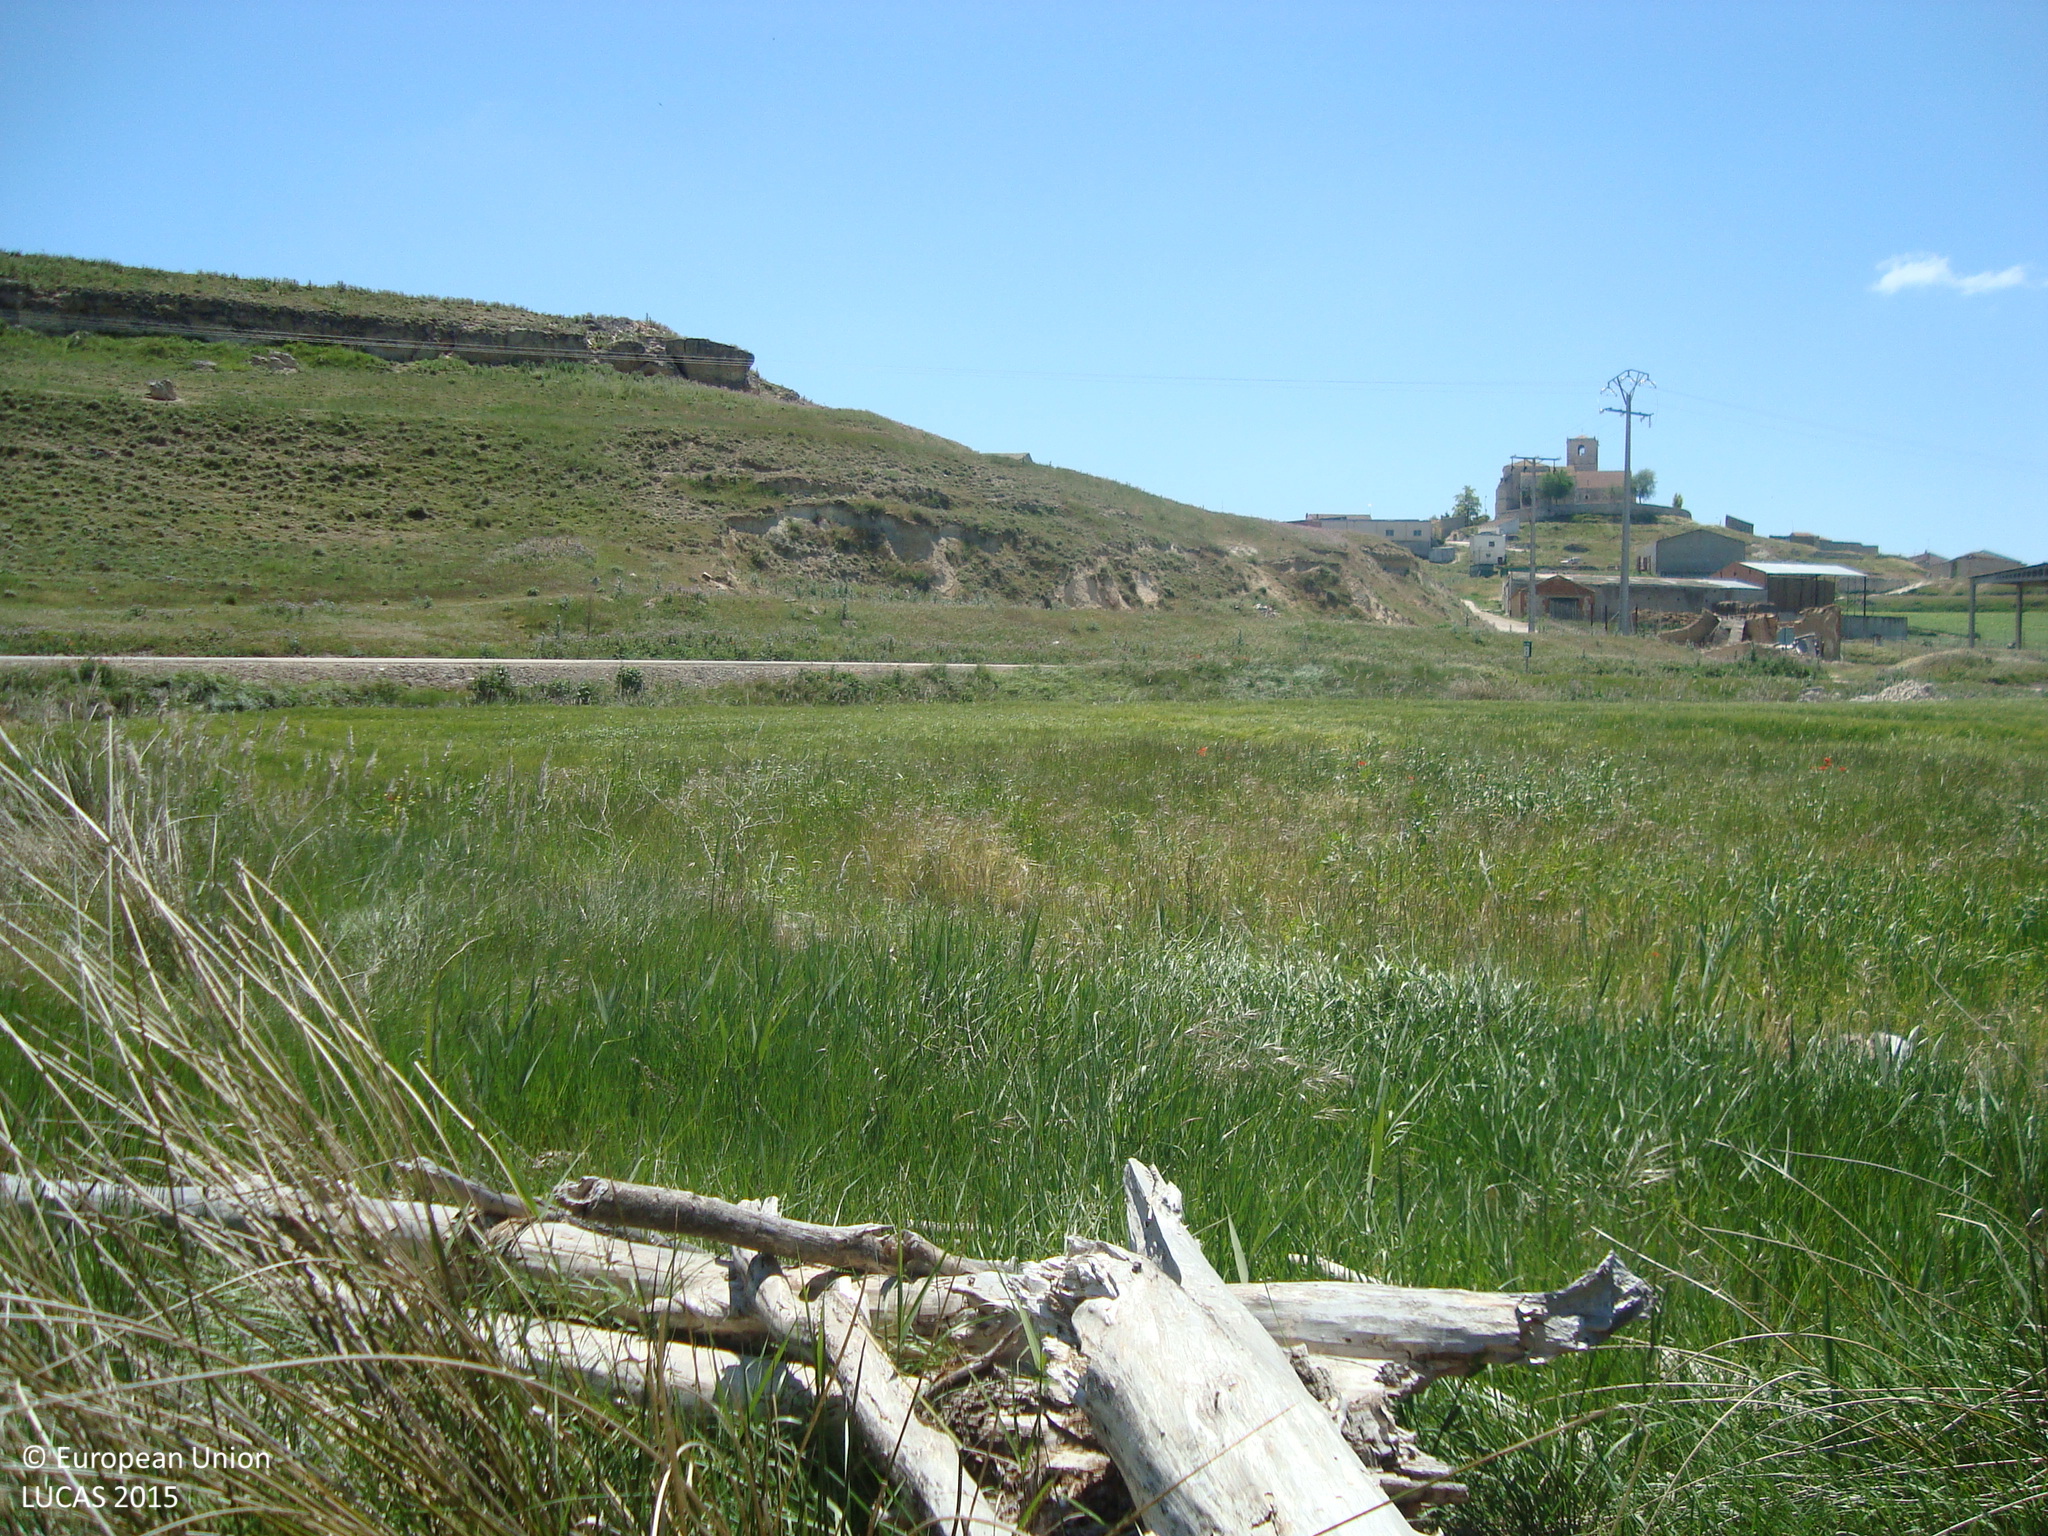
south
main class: Grassland
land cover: Grassland without tree/shrub cover
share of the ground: > 75 %
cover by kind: herbaceous plants 100 %
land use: Semi-natural and natural areas not in use
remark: Temporary flooded
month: May
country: ES
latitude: 41.5746
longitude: -4.1994
